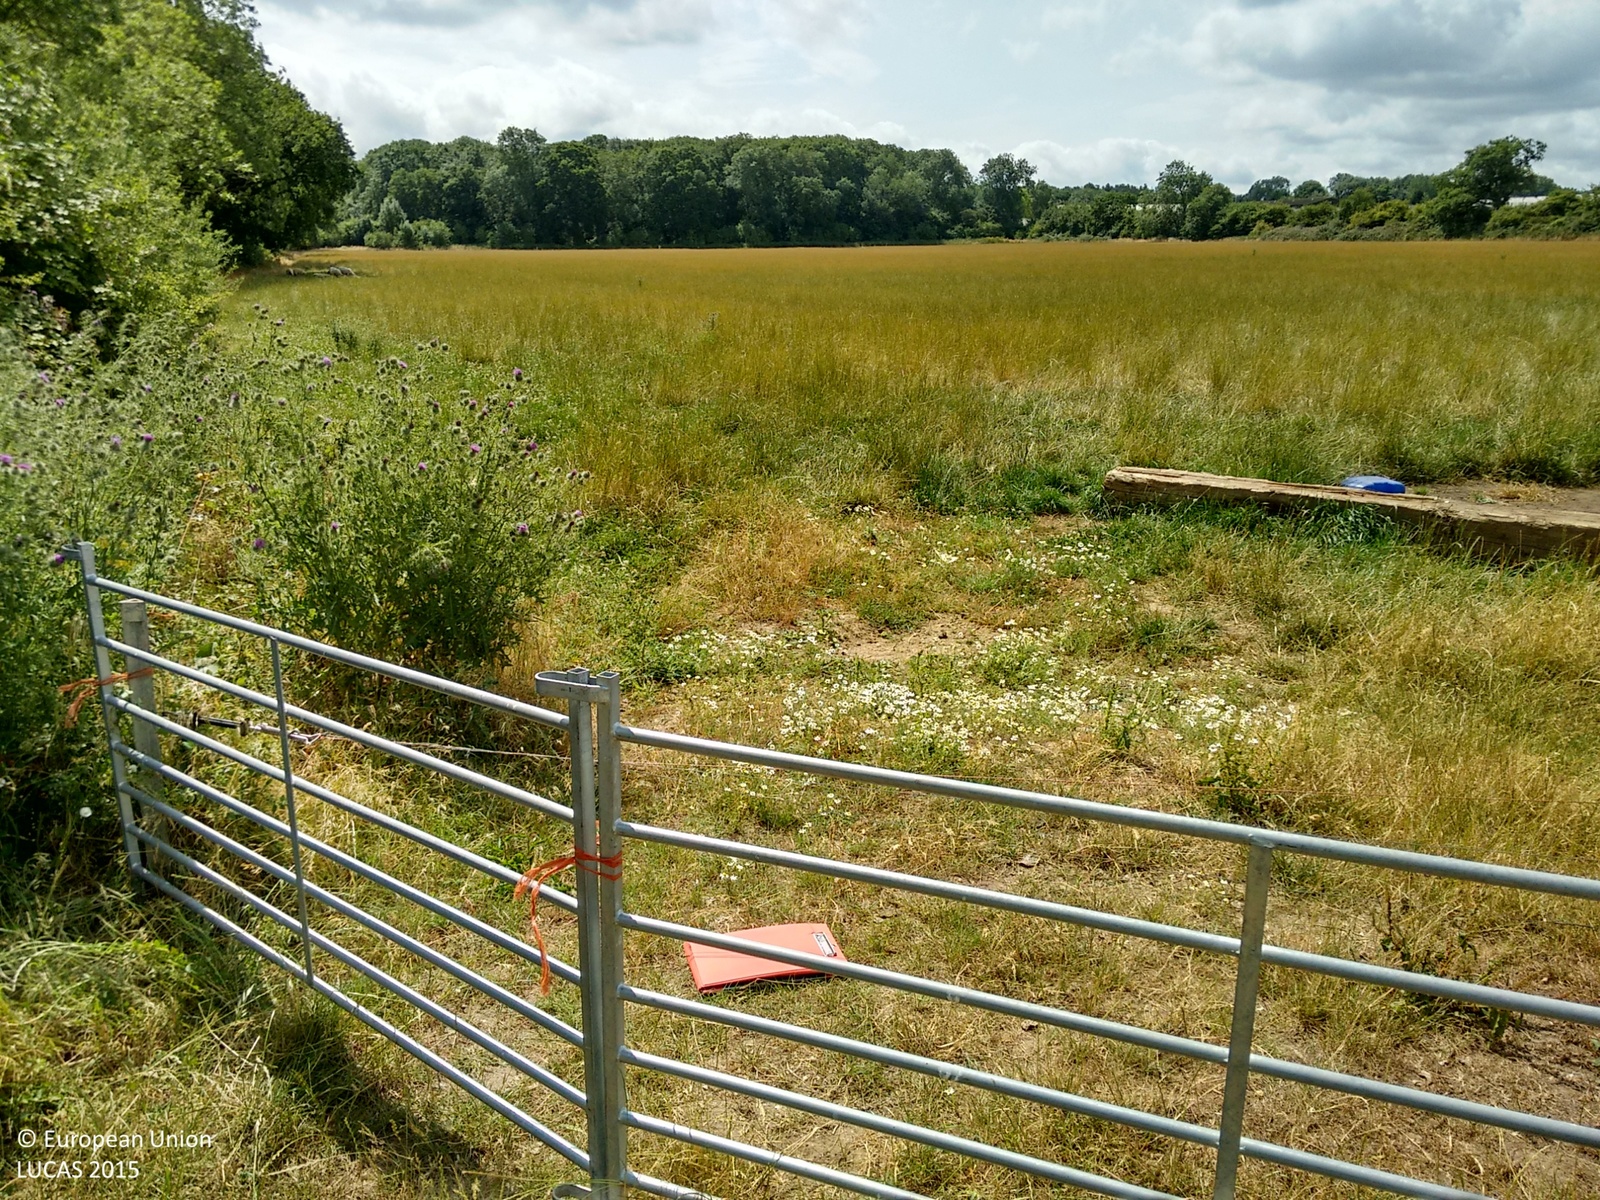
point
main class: Grassland
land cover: Grassland without tree/shrub cover
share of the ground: > 75 %
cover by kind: herbaceous plants 100 %
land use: Agriculture (excluding fallow land and kitchen gardens)
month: July
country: GB
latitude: 51.2768
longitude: -0.4887
